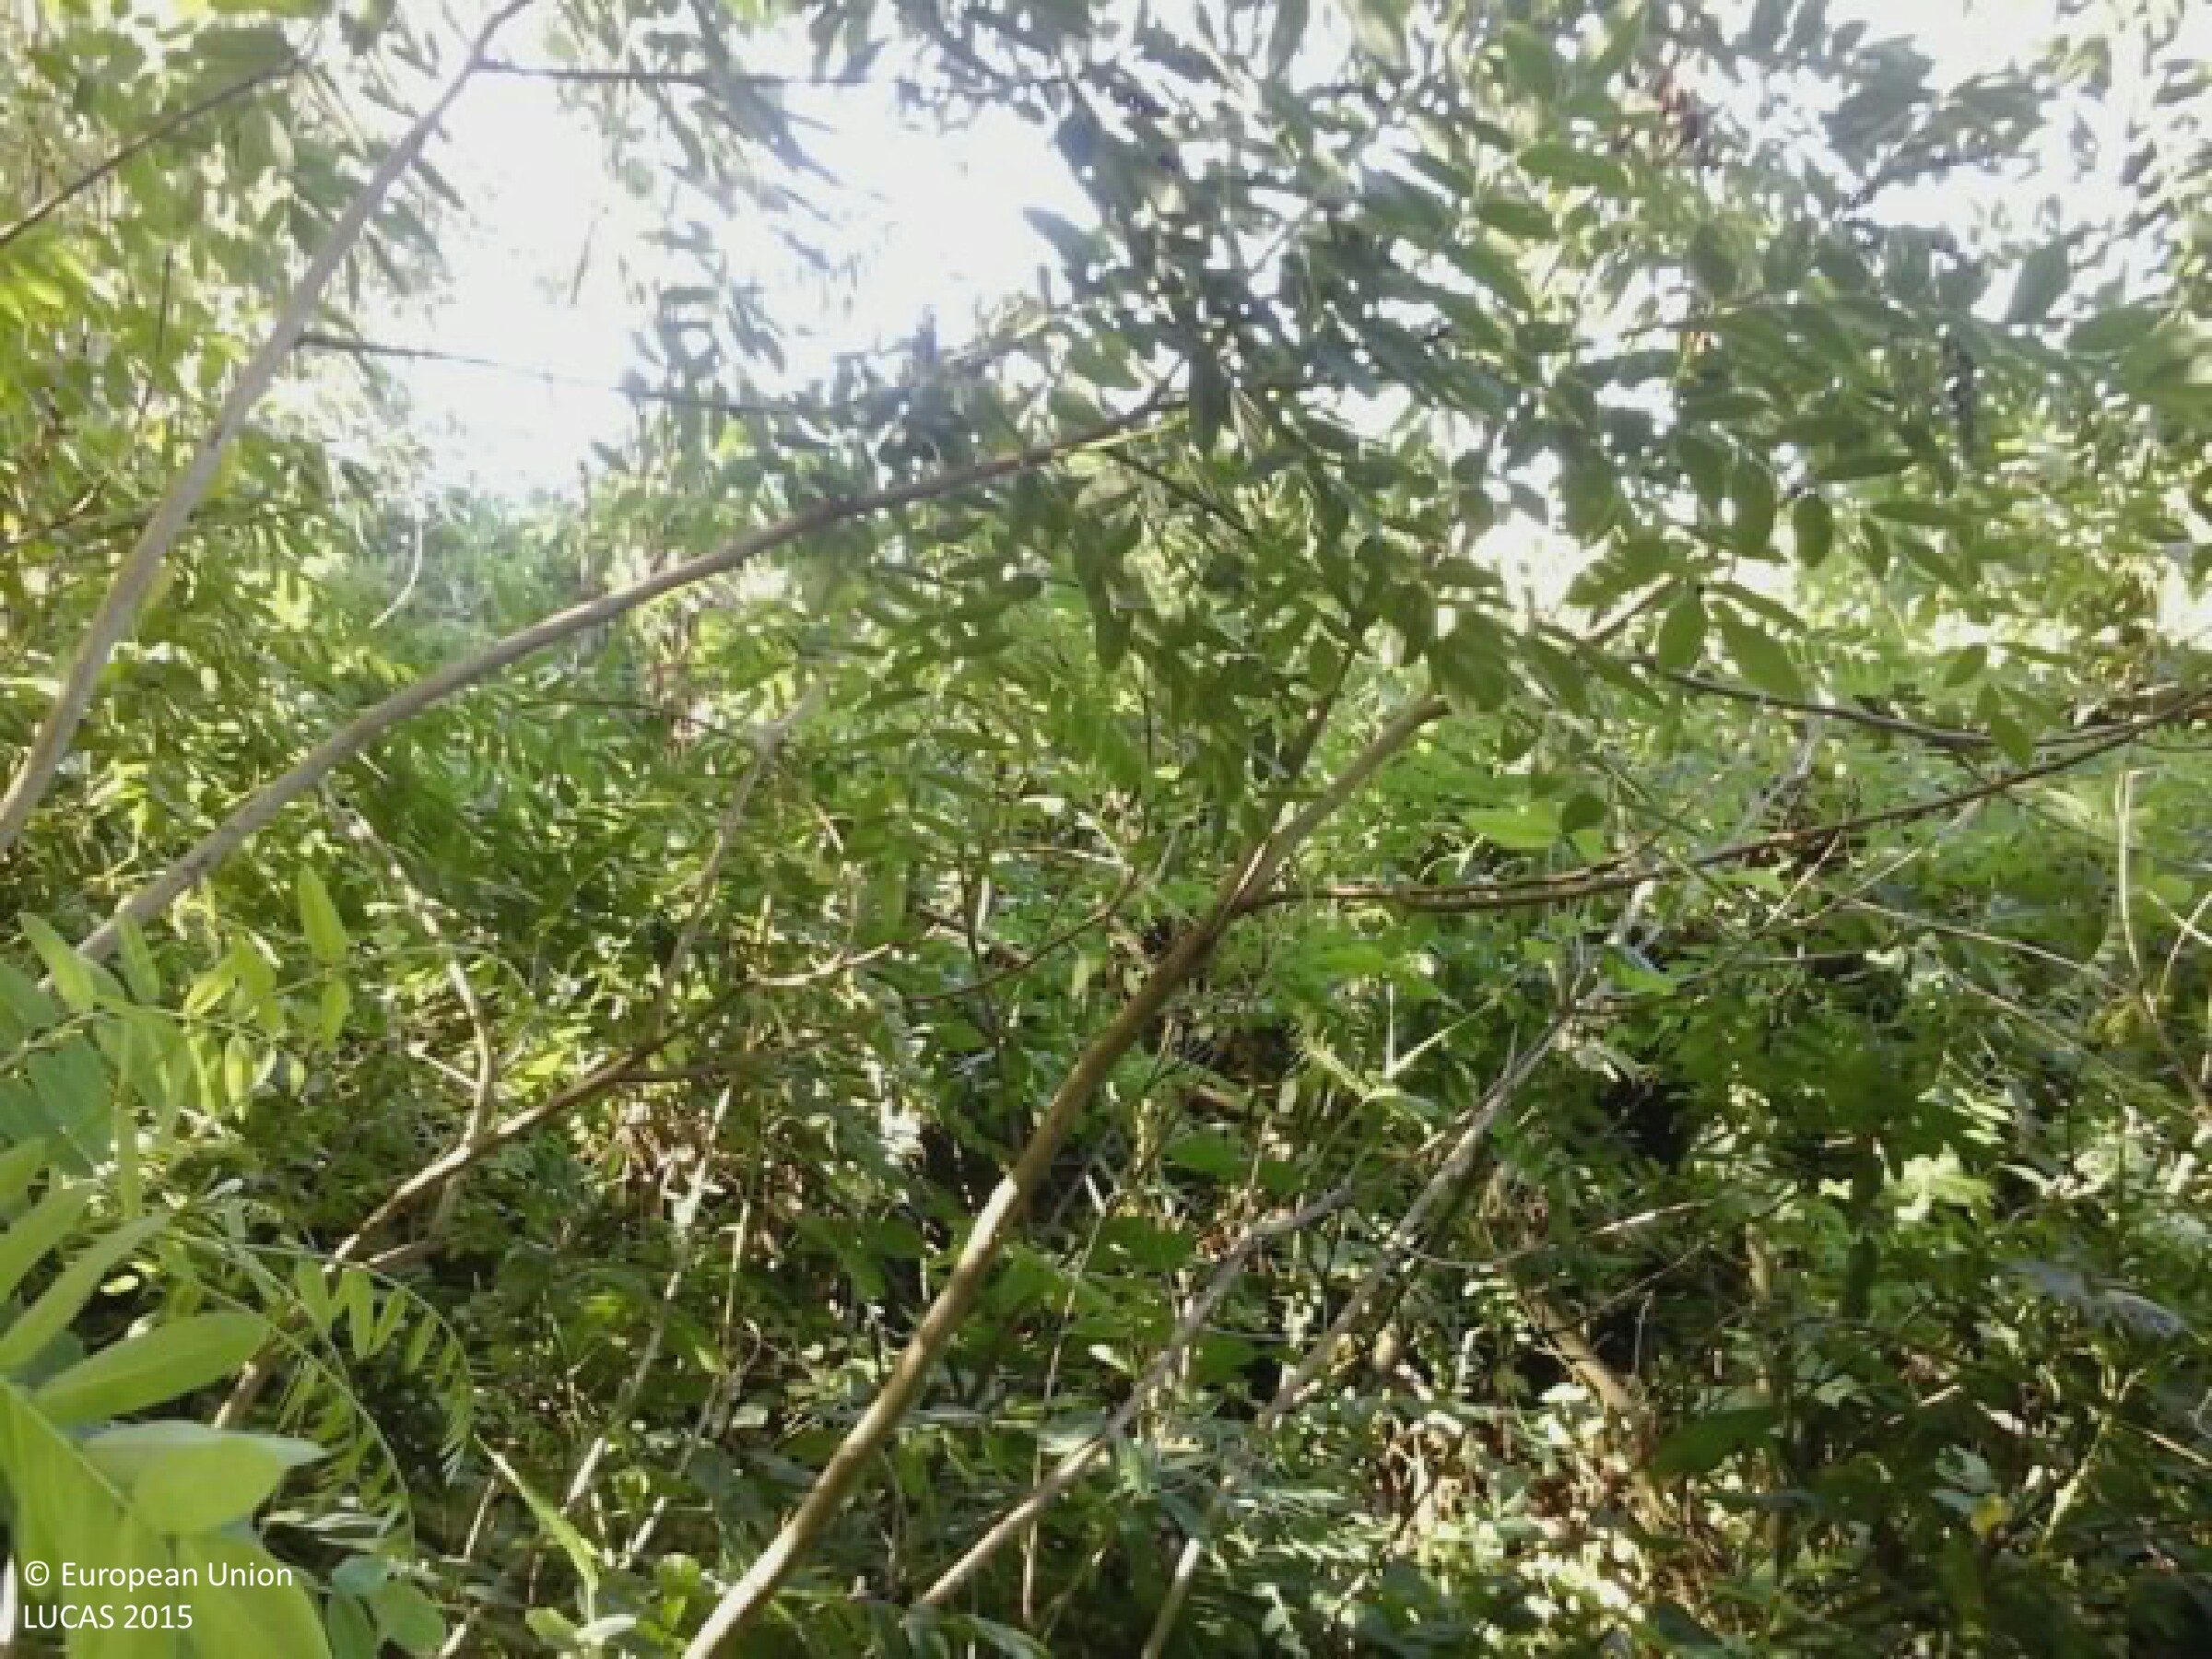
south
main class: Woodland
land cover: Broadleaved woodland
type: floodplain forest
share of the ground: > 75 %
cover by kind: broadleaved forest trees 75 %, shrubs 15 %, herbaceous plants 10 %
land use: Forestry
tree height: > 5 m
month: July
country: HU
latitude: 46.5796
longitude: 18.8735
